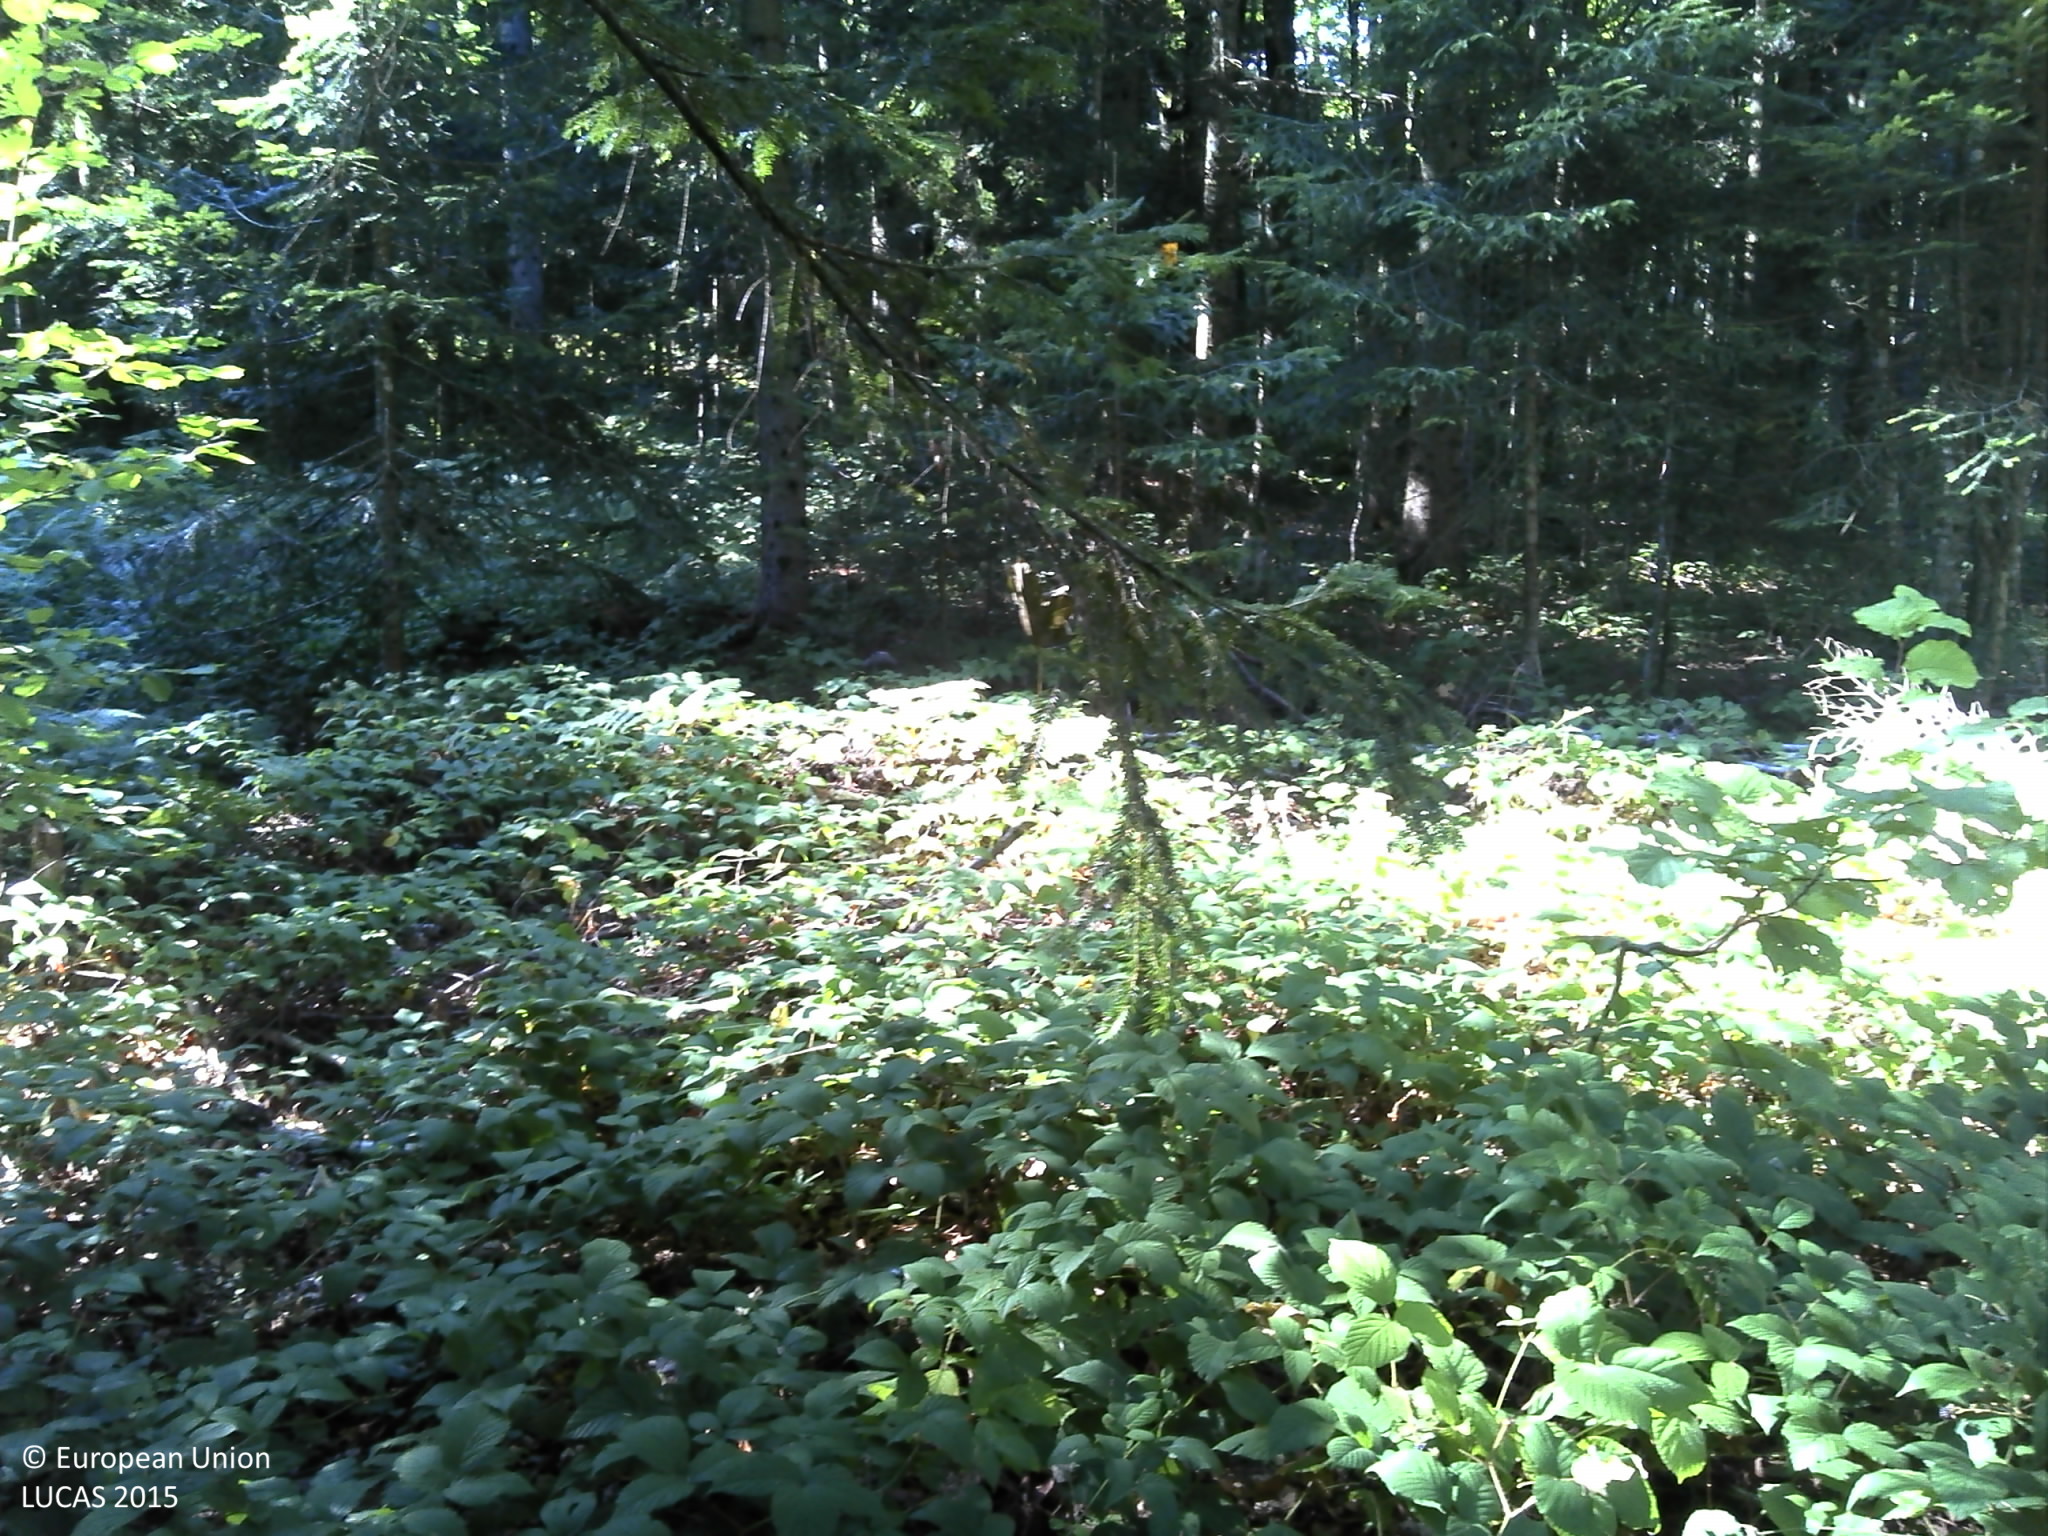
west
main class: Woodland
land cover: Pine dominated coniferous woodland
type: coniferous forest of the mediterranean region
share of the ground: > 75 %
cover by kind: coniferous forest trees 100 %
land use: Forestry
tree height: > 5 m
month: August
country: HR
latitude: 45.1070
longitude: 15.1676
